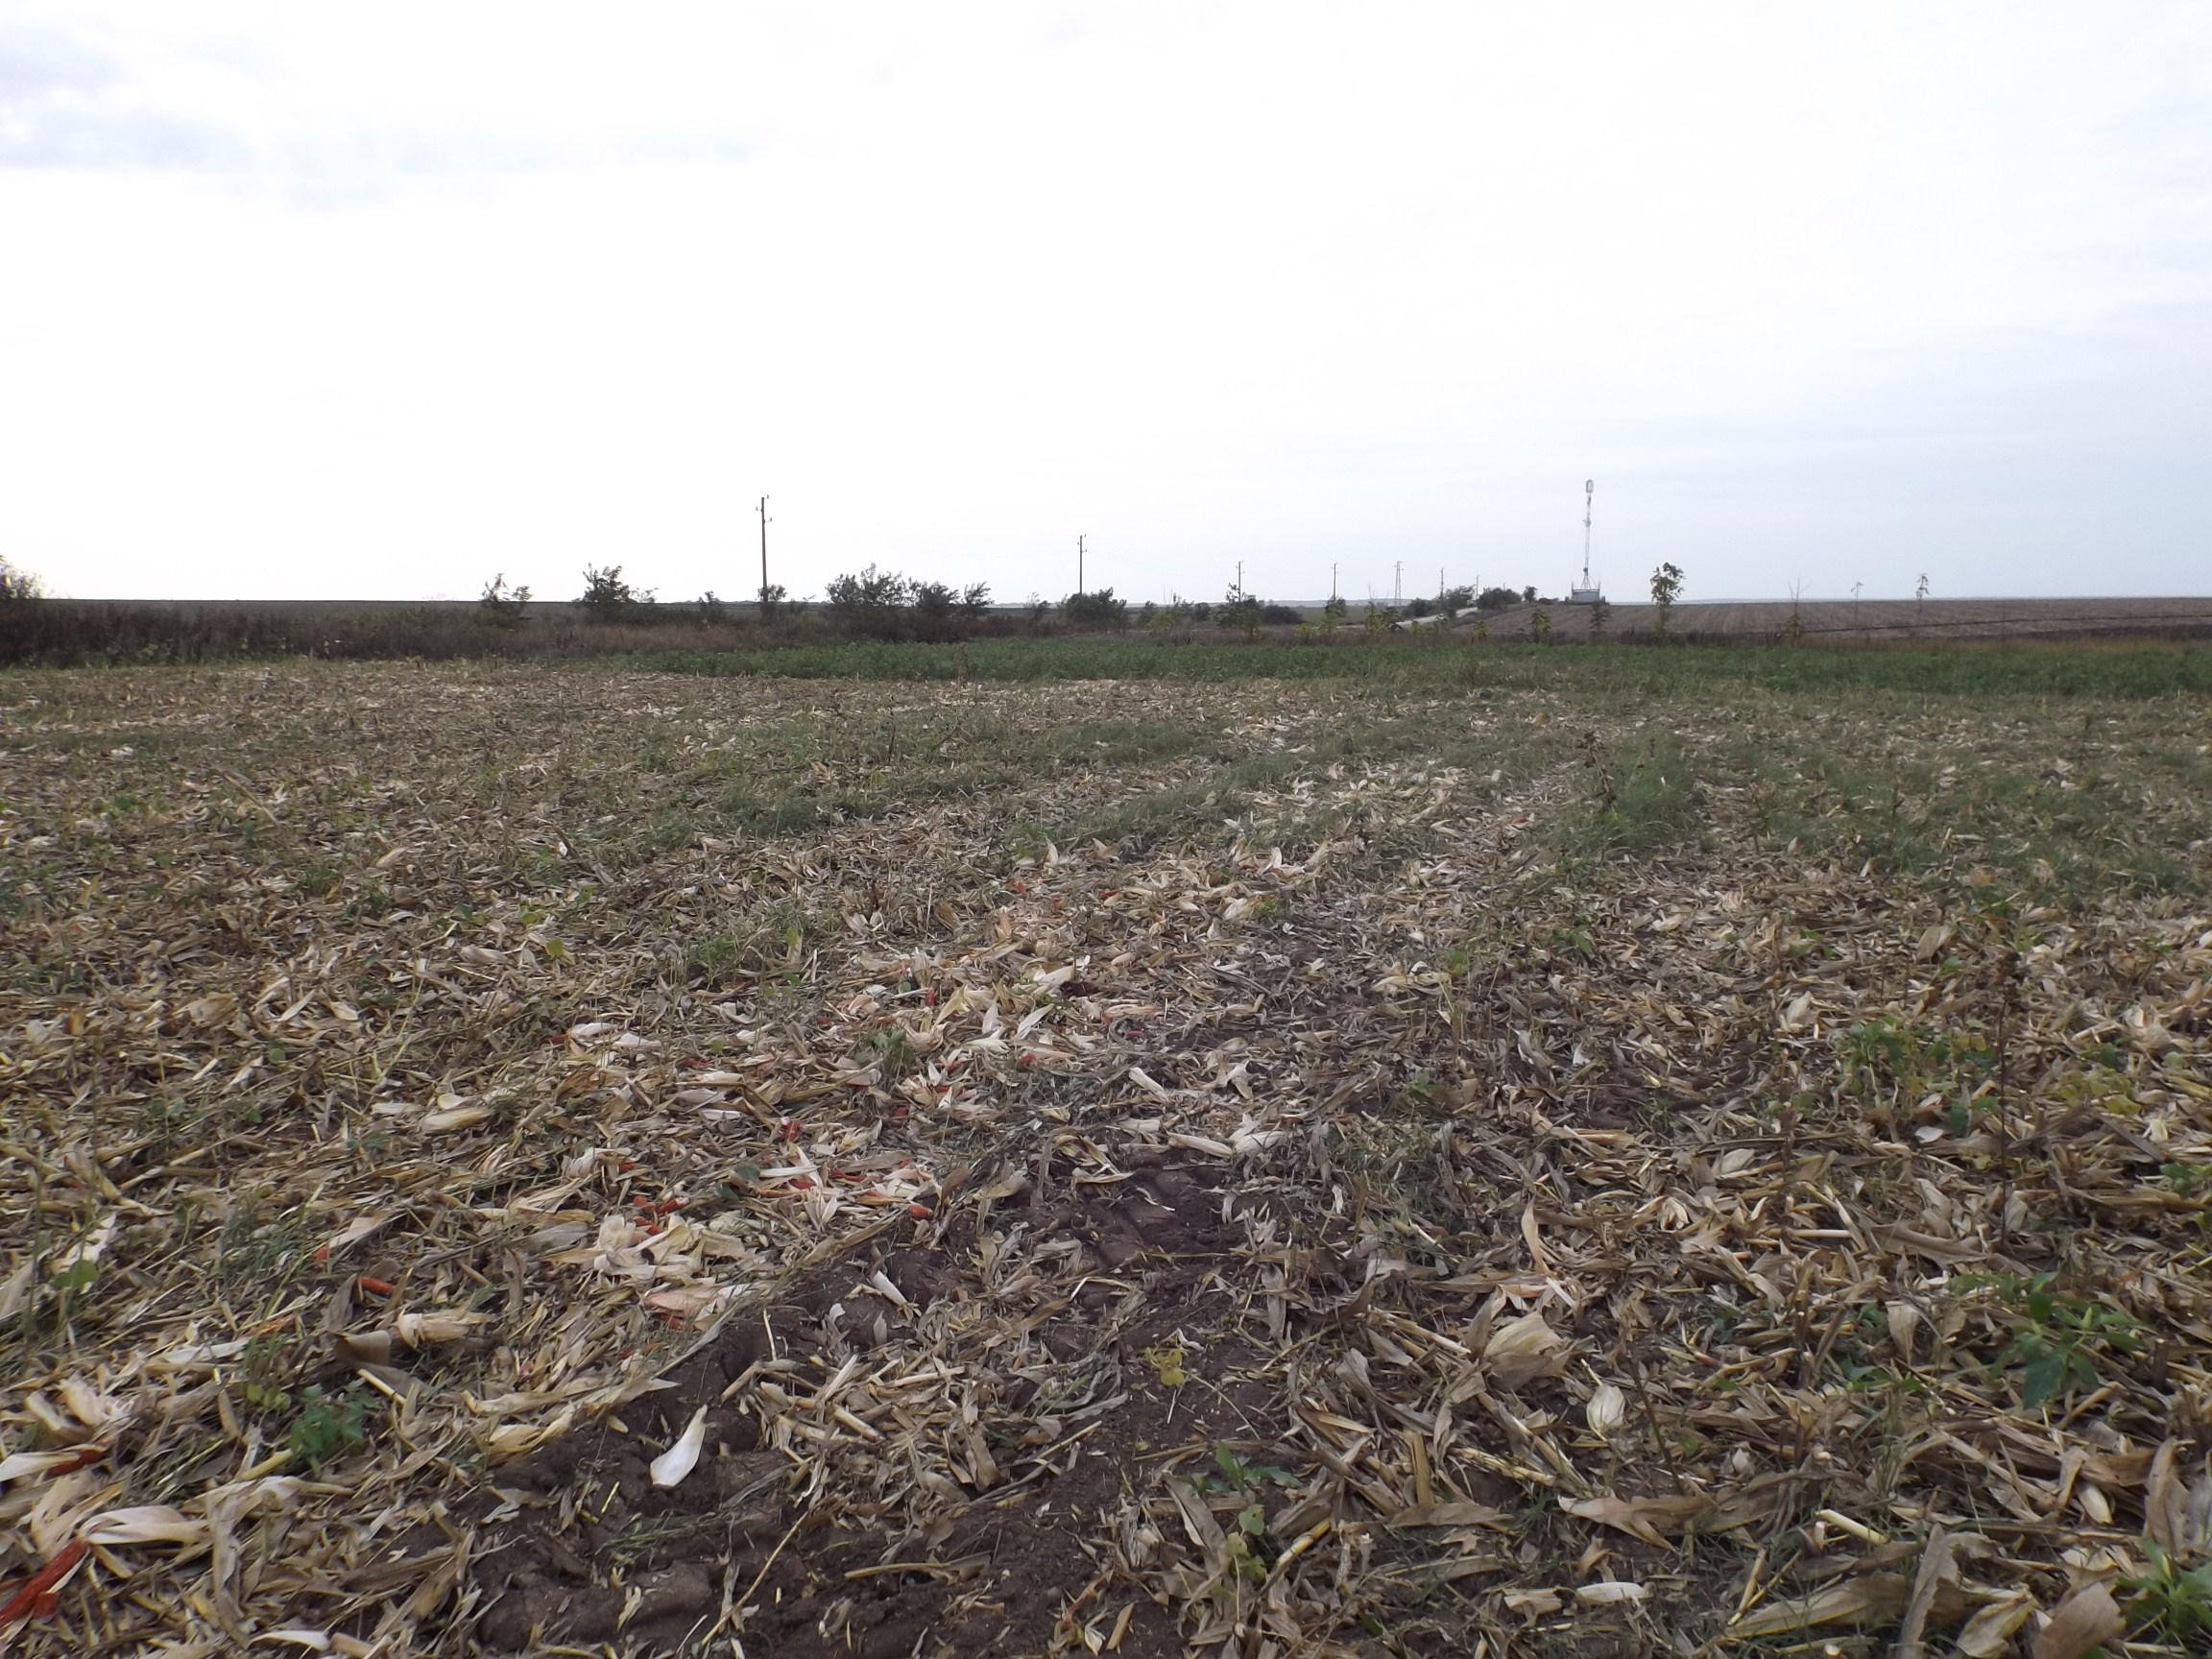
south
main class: Cropland
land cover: Maize
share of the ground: < 10 %
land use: Agriculture (excluding fallow land and kitchen gardens)
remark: Harvested field
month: October
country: BG
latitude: 43.9357
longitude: 26.8488
